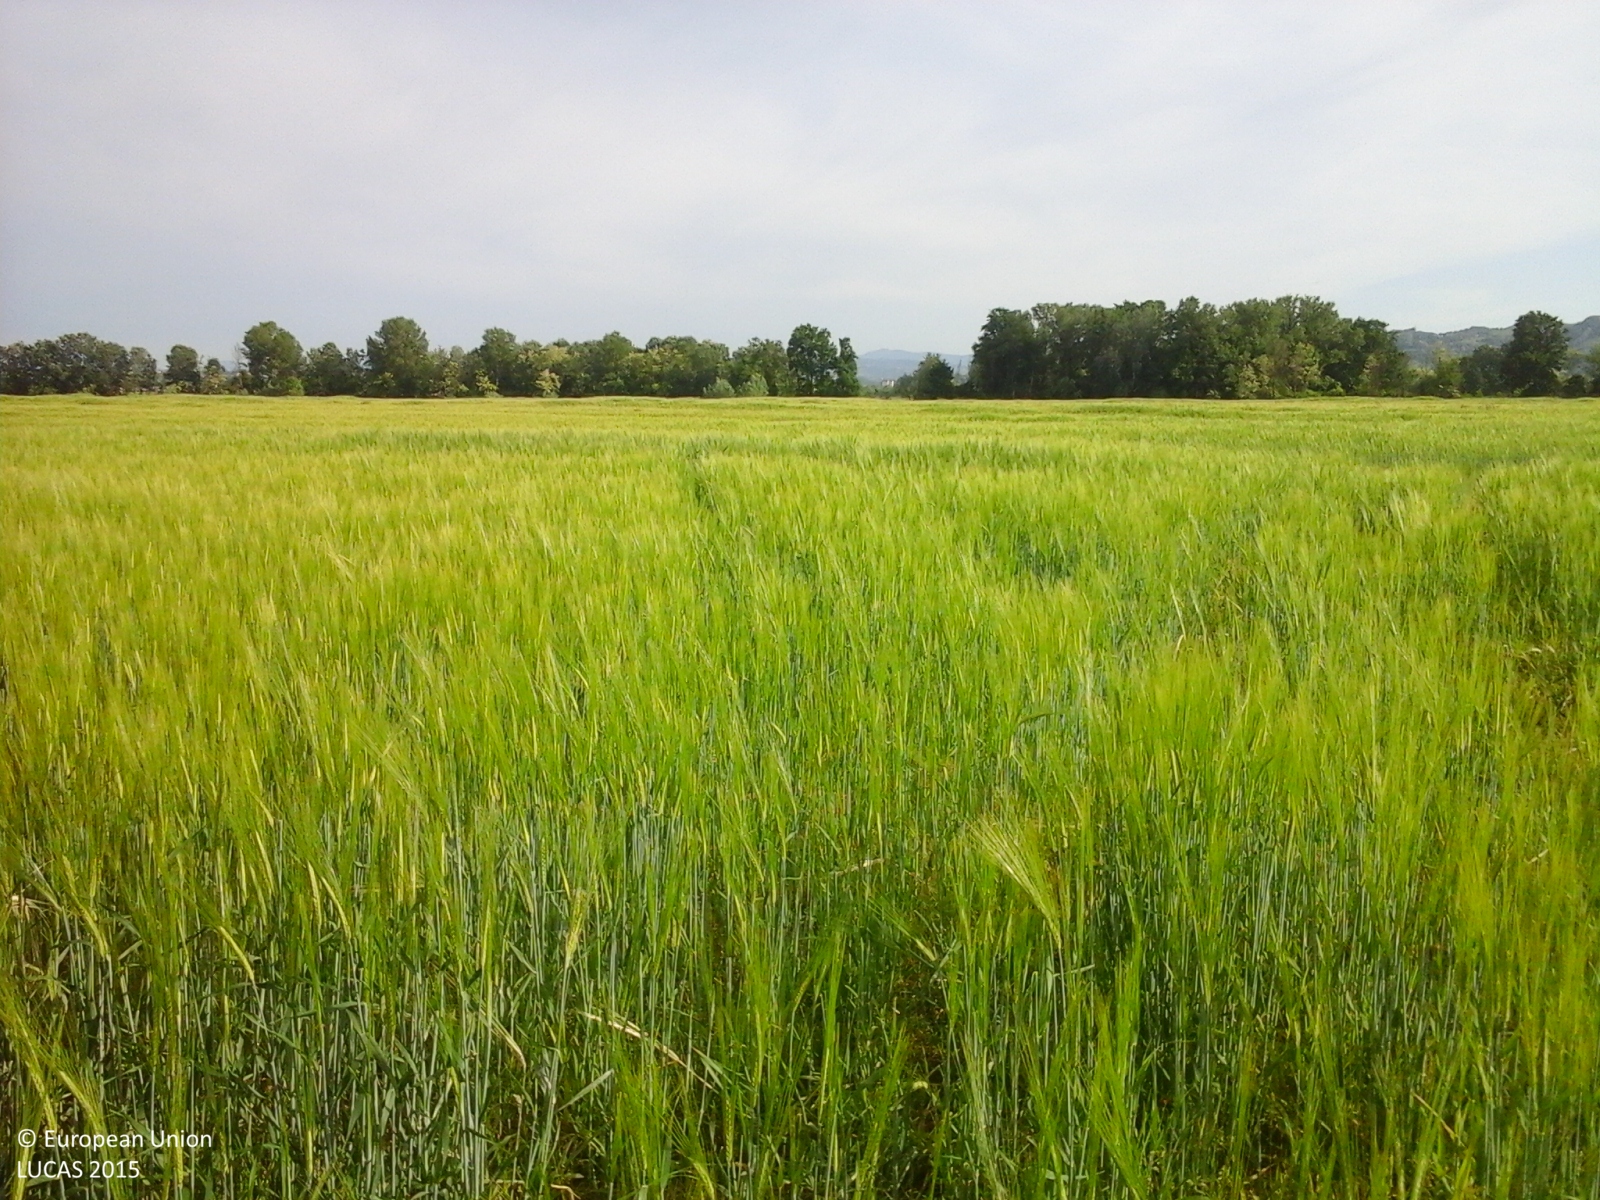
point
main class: Cropland
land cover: Barley
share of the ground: > 75 %
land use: Agriculture (excluding fallow land and kitchen gardens)
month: May
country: IT
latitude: 45.1056
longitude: 9.3023
